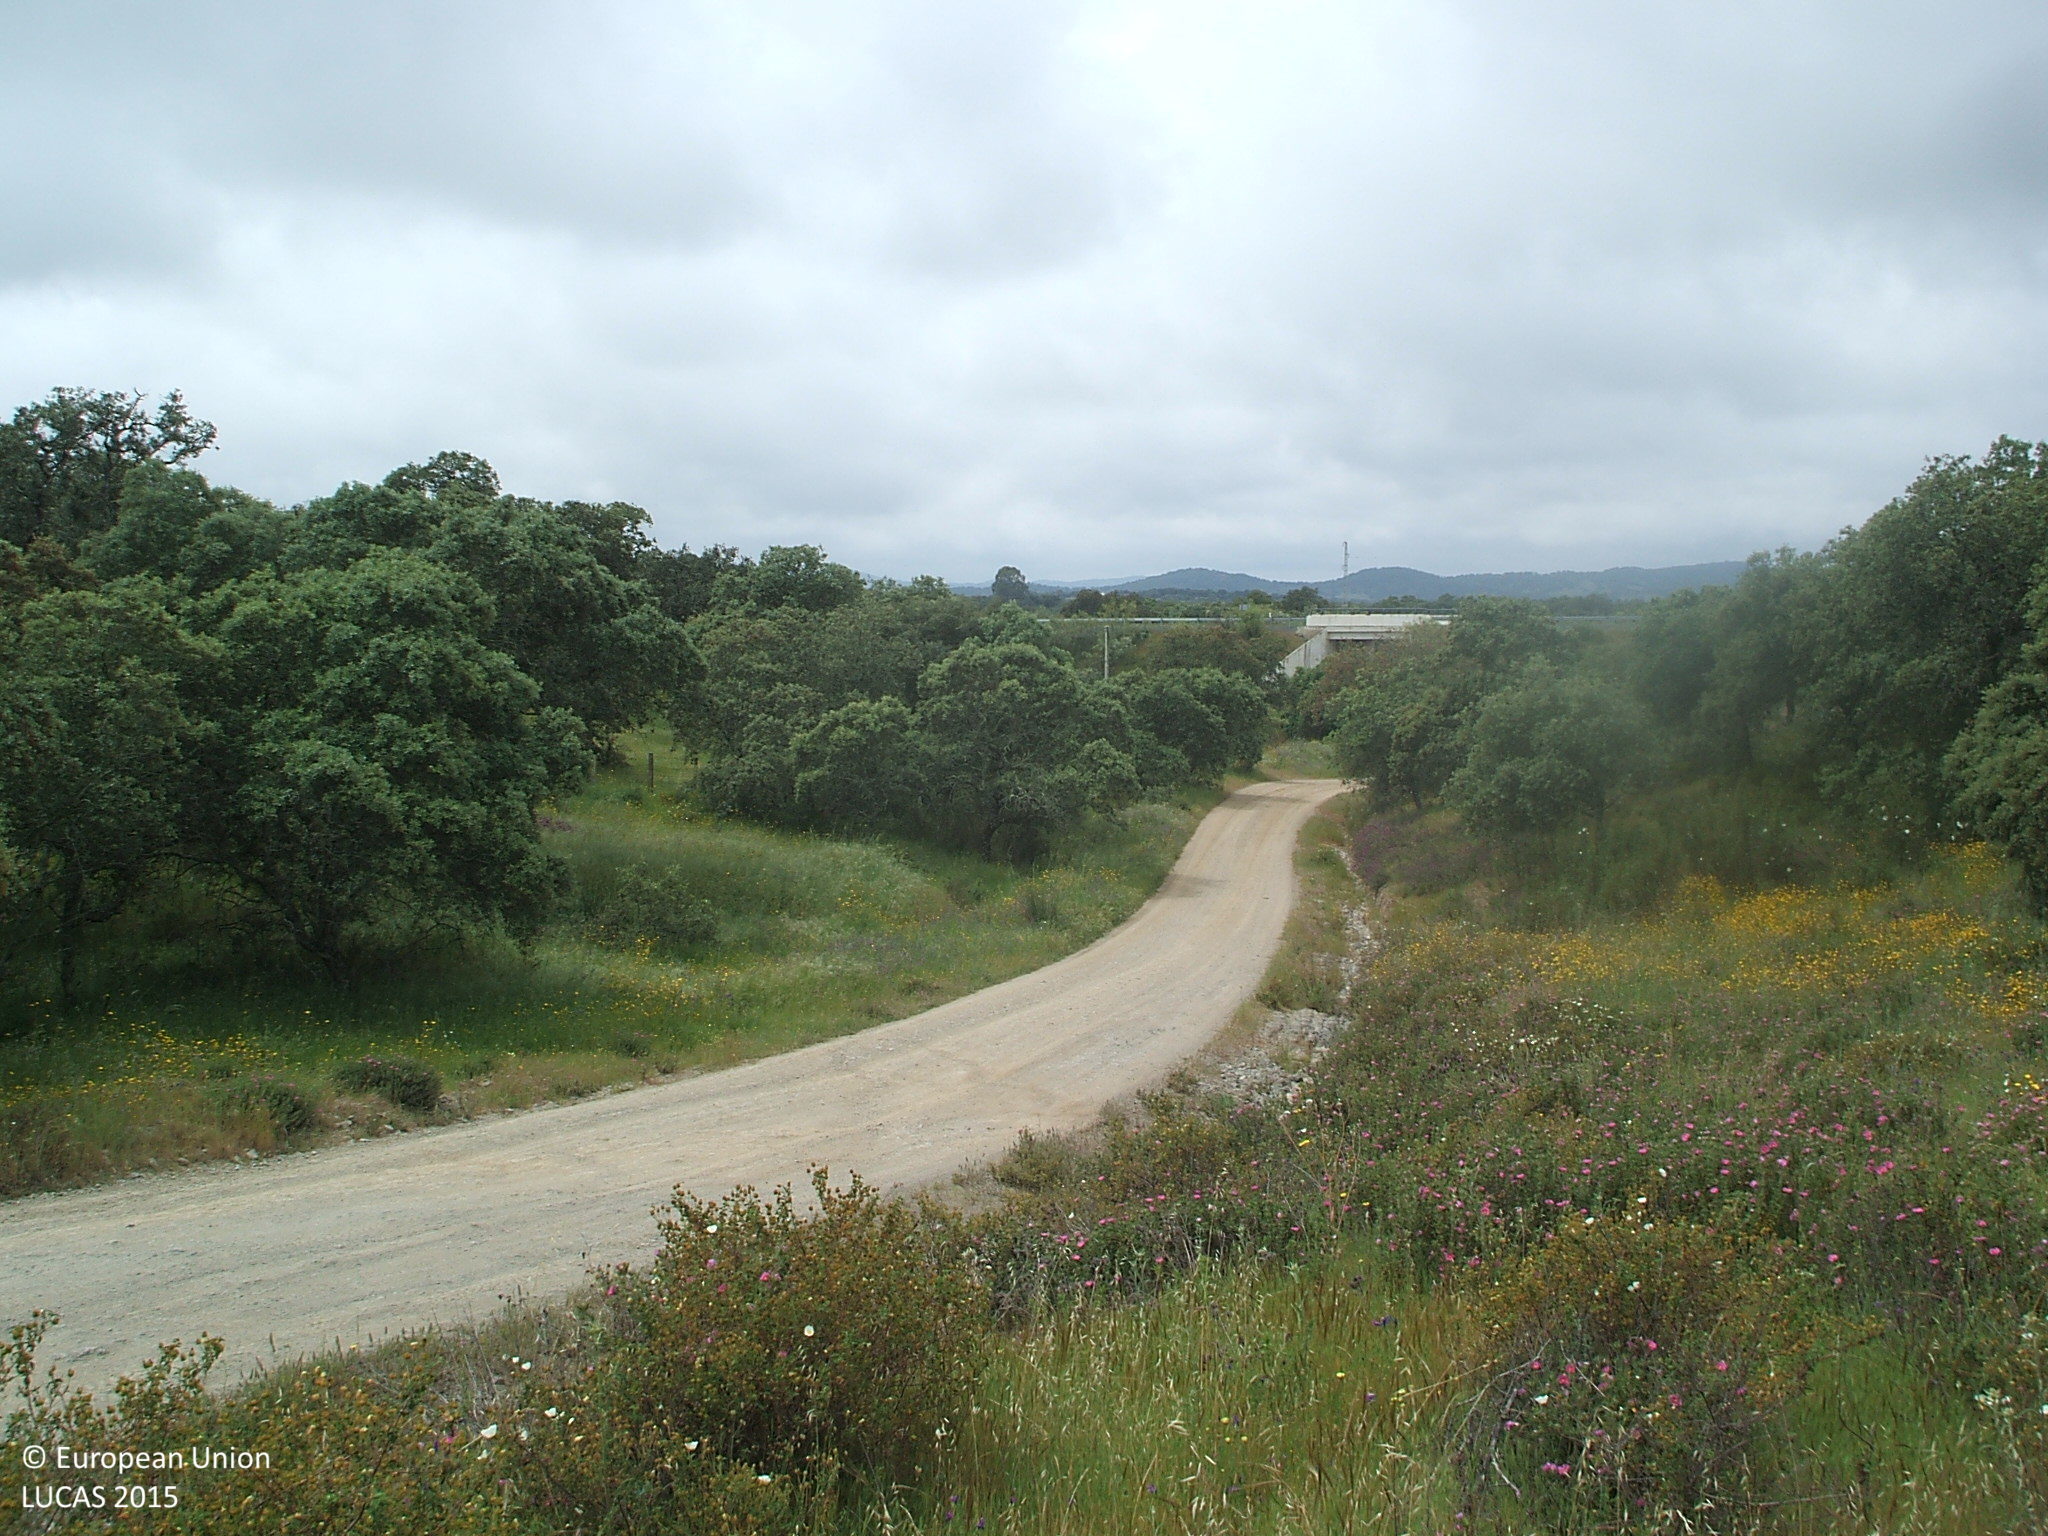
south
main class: Woodland
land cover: Broadleaved woodland
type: broadleaved evergreen forest
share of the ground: 25 - 50 %
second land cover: Grassland without tree/shrub cover
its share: > 75 %
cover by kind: herbaceous plants 60 %, broadleaved forest trees 40 %
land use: Forestry
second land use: Agriculture (excluding fallow land and kitchen gardens)
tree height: > 5 m
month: April
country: ES
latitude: 37.8326
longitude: -5.6031
